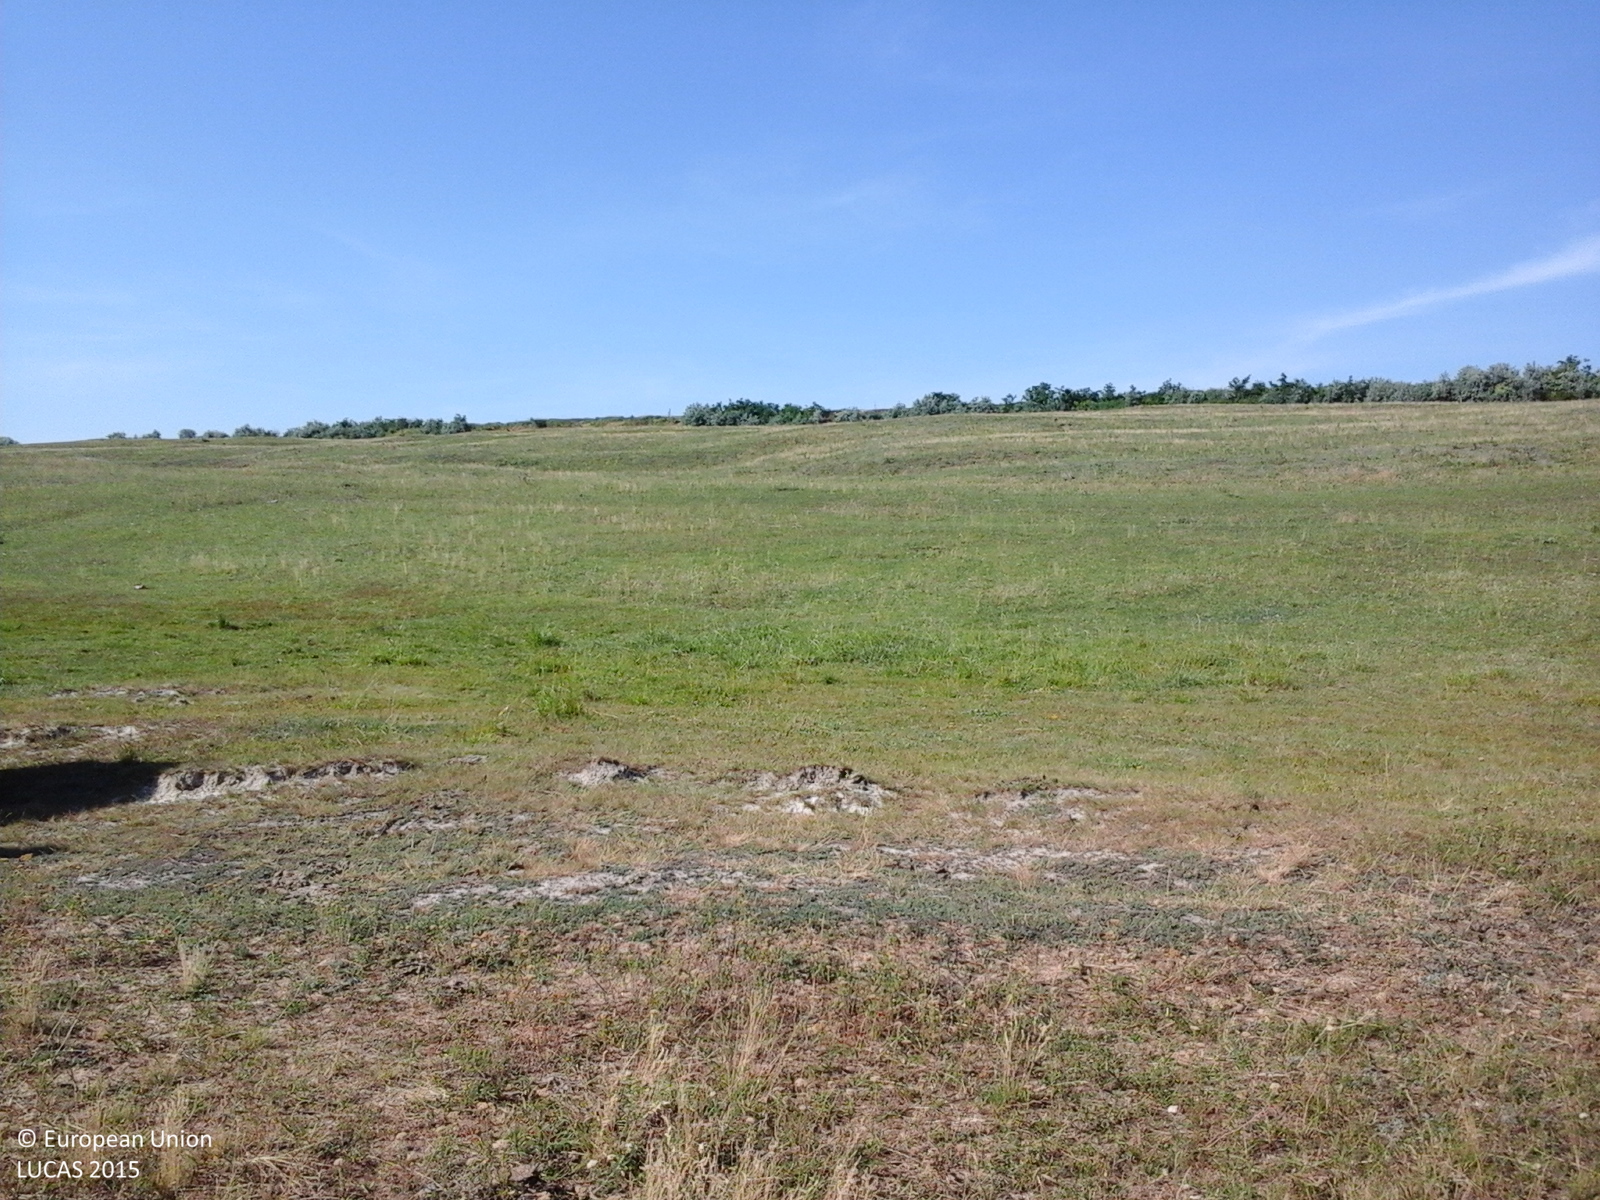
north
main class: Grassland
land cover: Grassland without tree/shrub cover
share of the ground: > 75 %
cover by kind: herbaceous plants 100 %
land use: Agriculture (excluding fallow land and kitchen gardens)
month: June
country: RO
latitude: 47.4976
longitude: 27.1112
